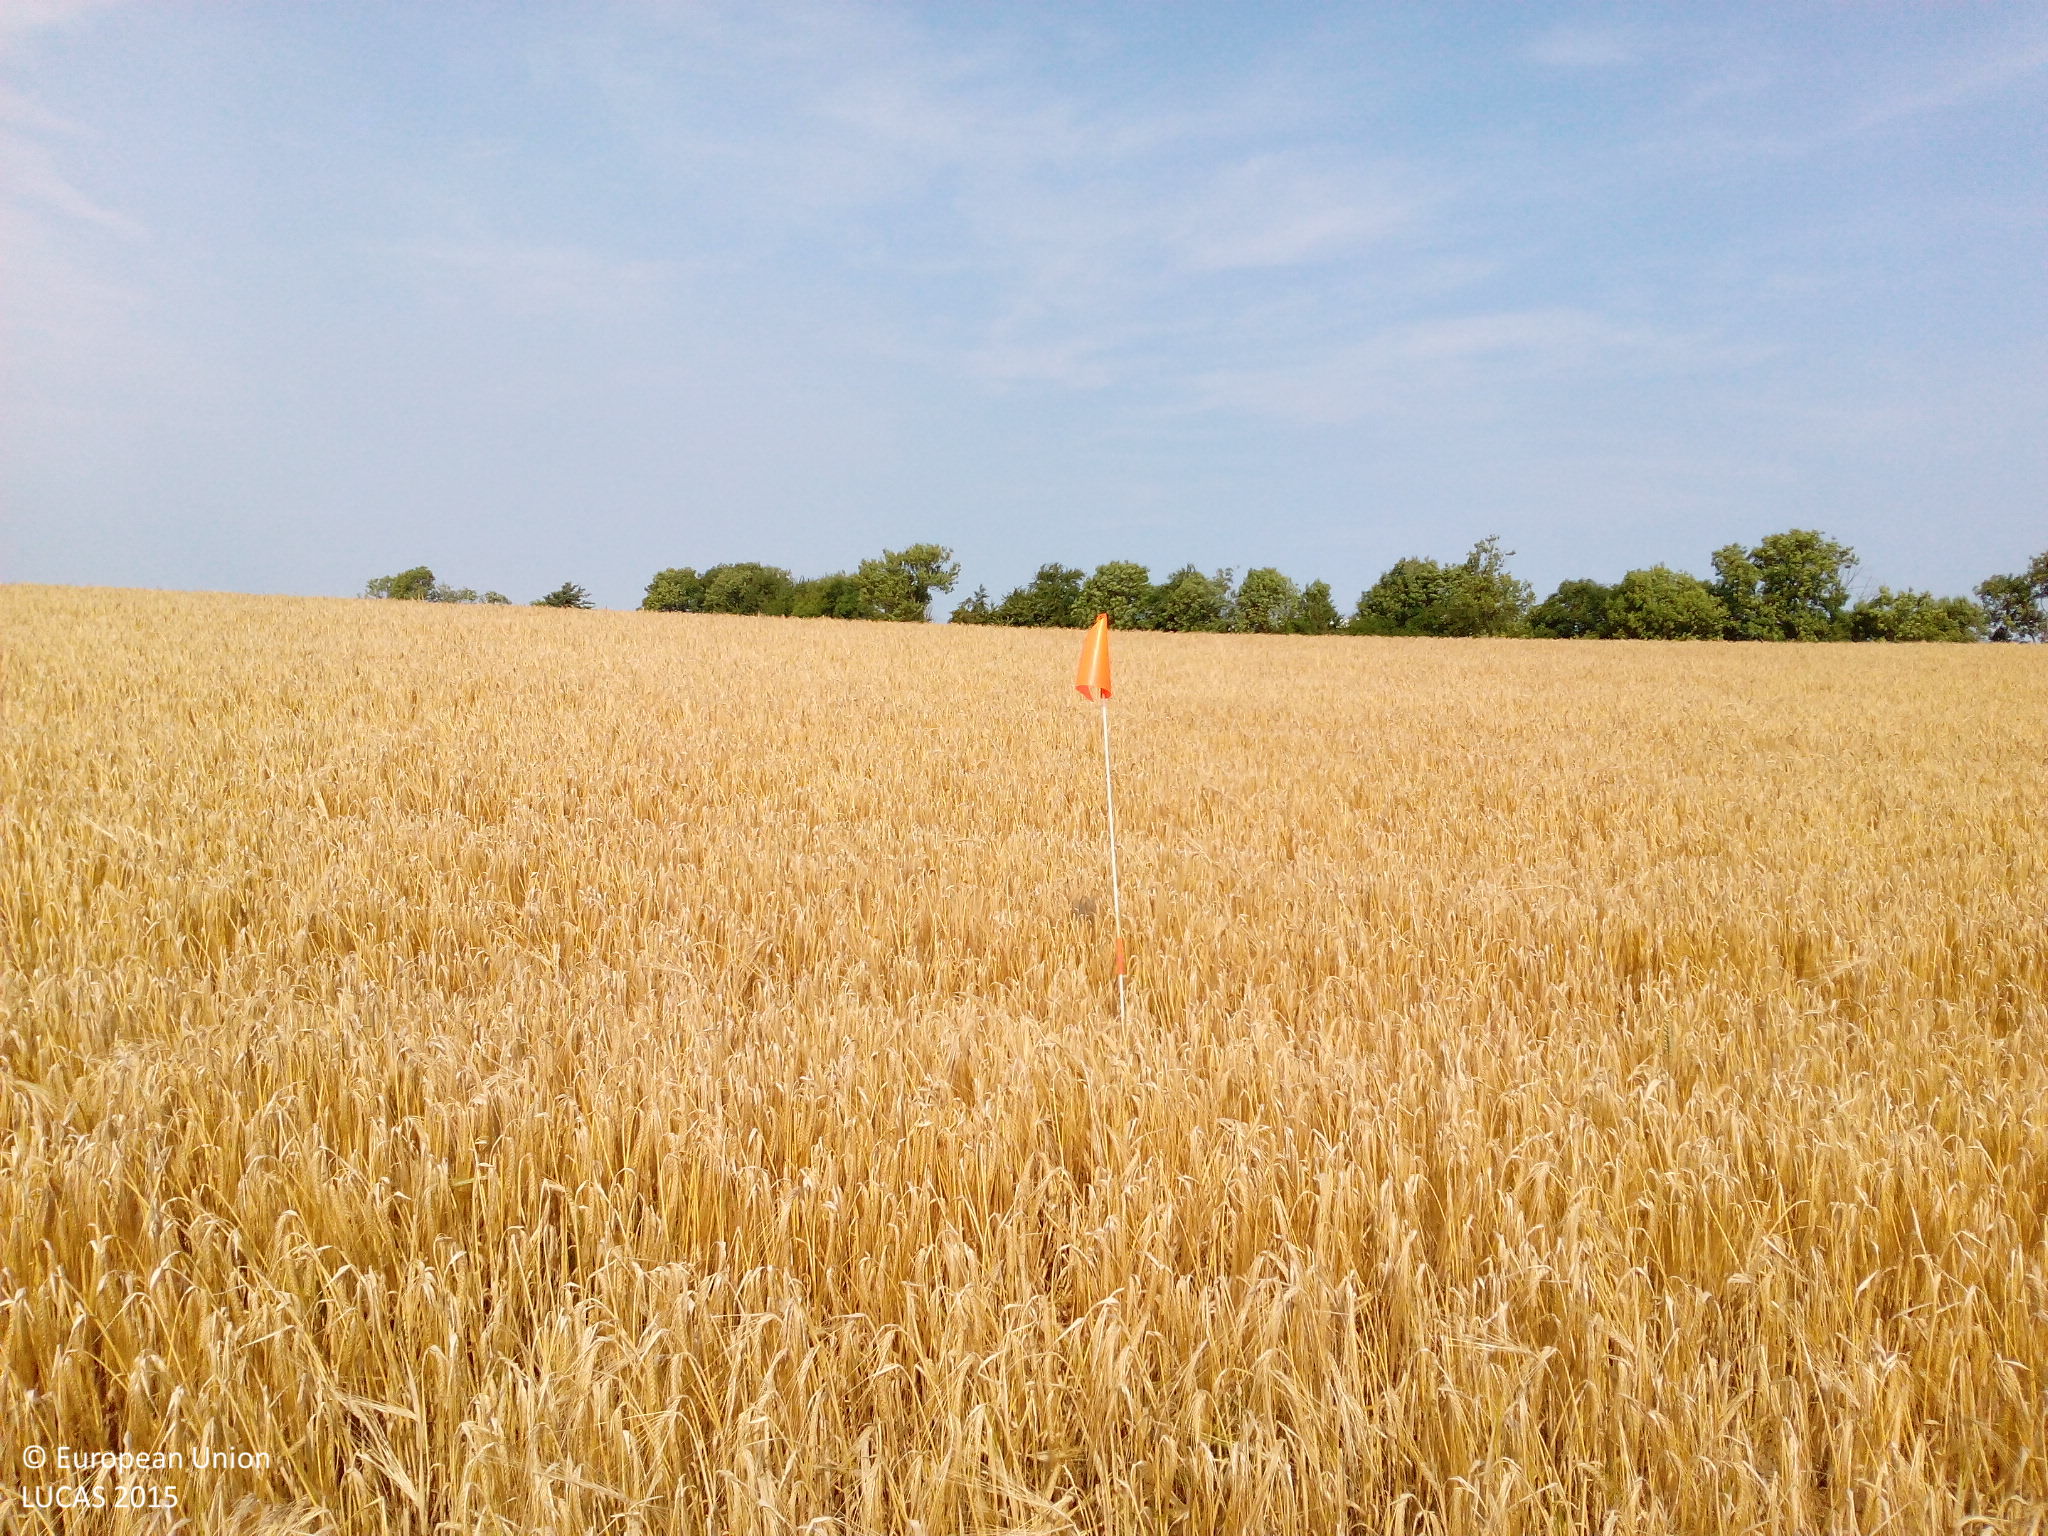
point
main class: Cropland
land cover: Barley
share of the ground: > 75 %
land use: Agriculture (excluding fallow land and kitchen gardens)
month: August
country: DK
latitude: 55.1714
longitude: 15.0087
